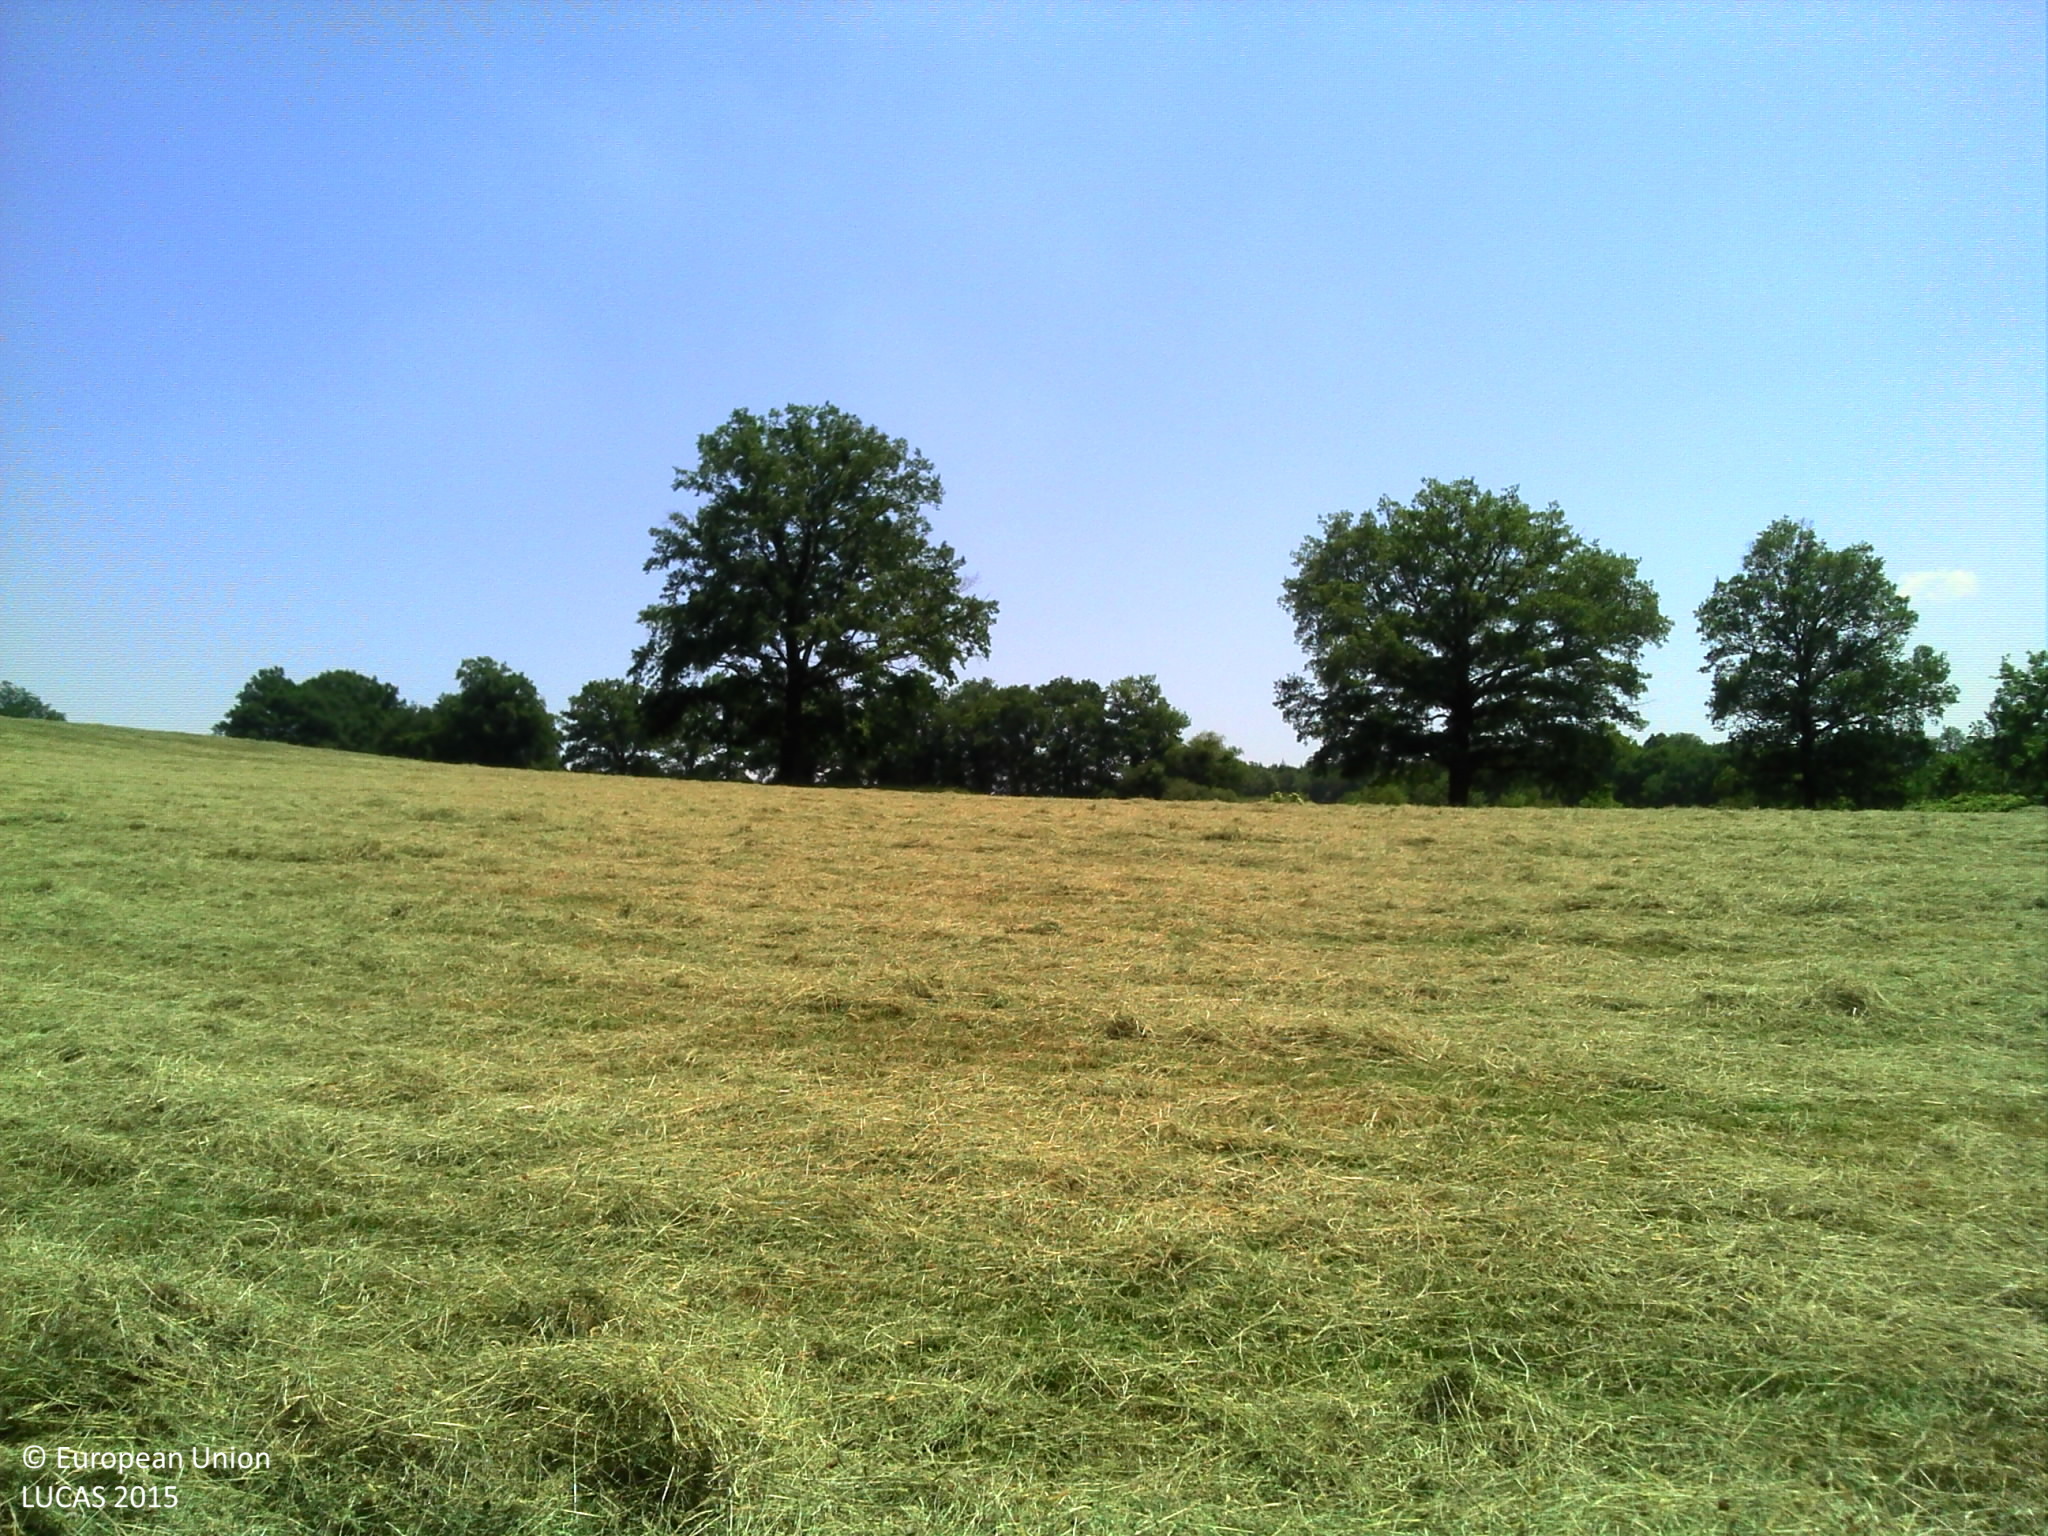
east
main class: Grassland
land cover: Grassland without tree/shrub cover
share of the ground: > 75 %
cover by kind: herbaceous plants 100 %
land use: Agriculture (excluding fallow land and kitchen gardens)
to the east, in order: Grassland without tree/shrub cover; Single bushes/trees; Grassland without tree/shrub cover; Managed hedges; Grassland without tree/shrub cover
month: June
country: FR
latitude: 46.3587
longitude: 2.7575
